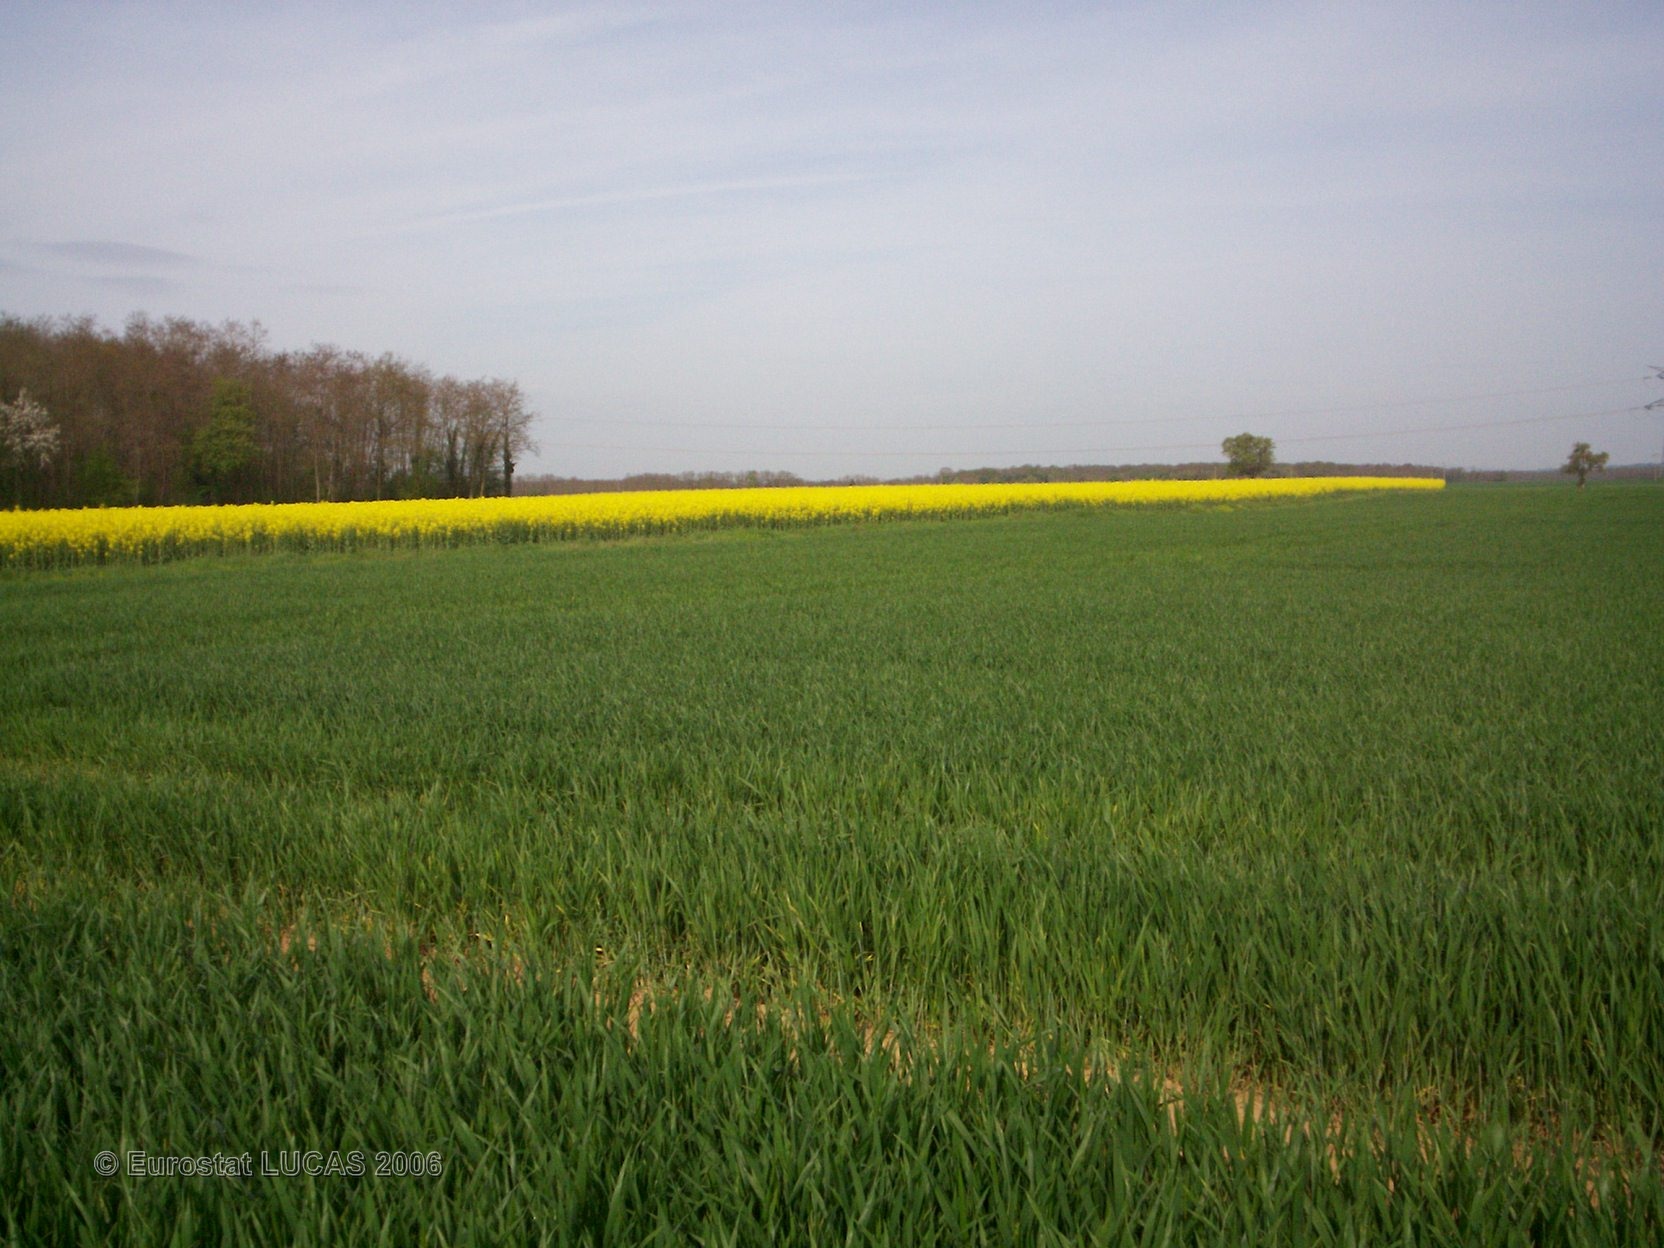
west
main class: Cropland
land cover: Common wheat
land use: Agriculture (excluding fallow land and kitchen gardens)
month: May
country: FR
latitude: 47.2639
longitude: 3.0566
